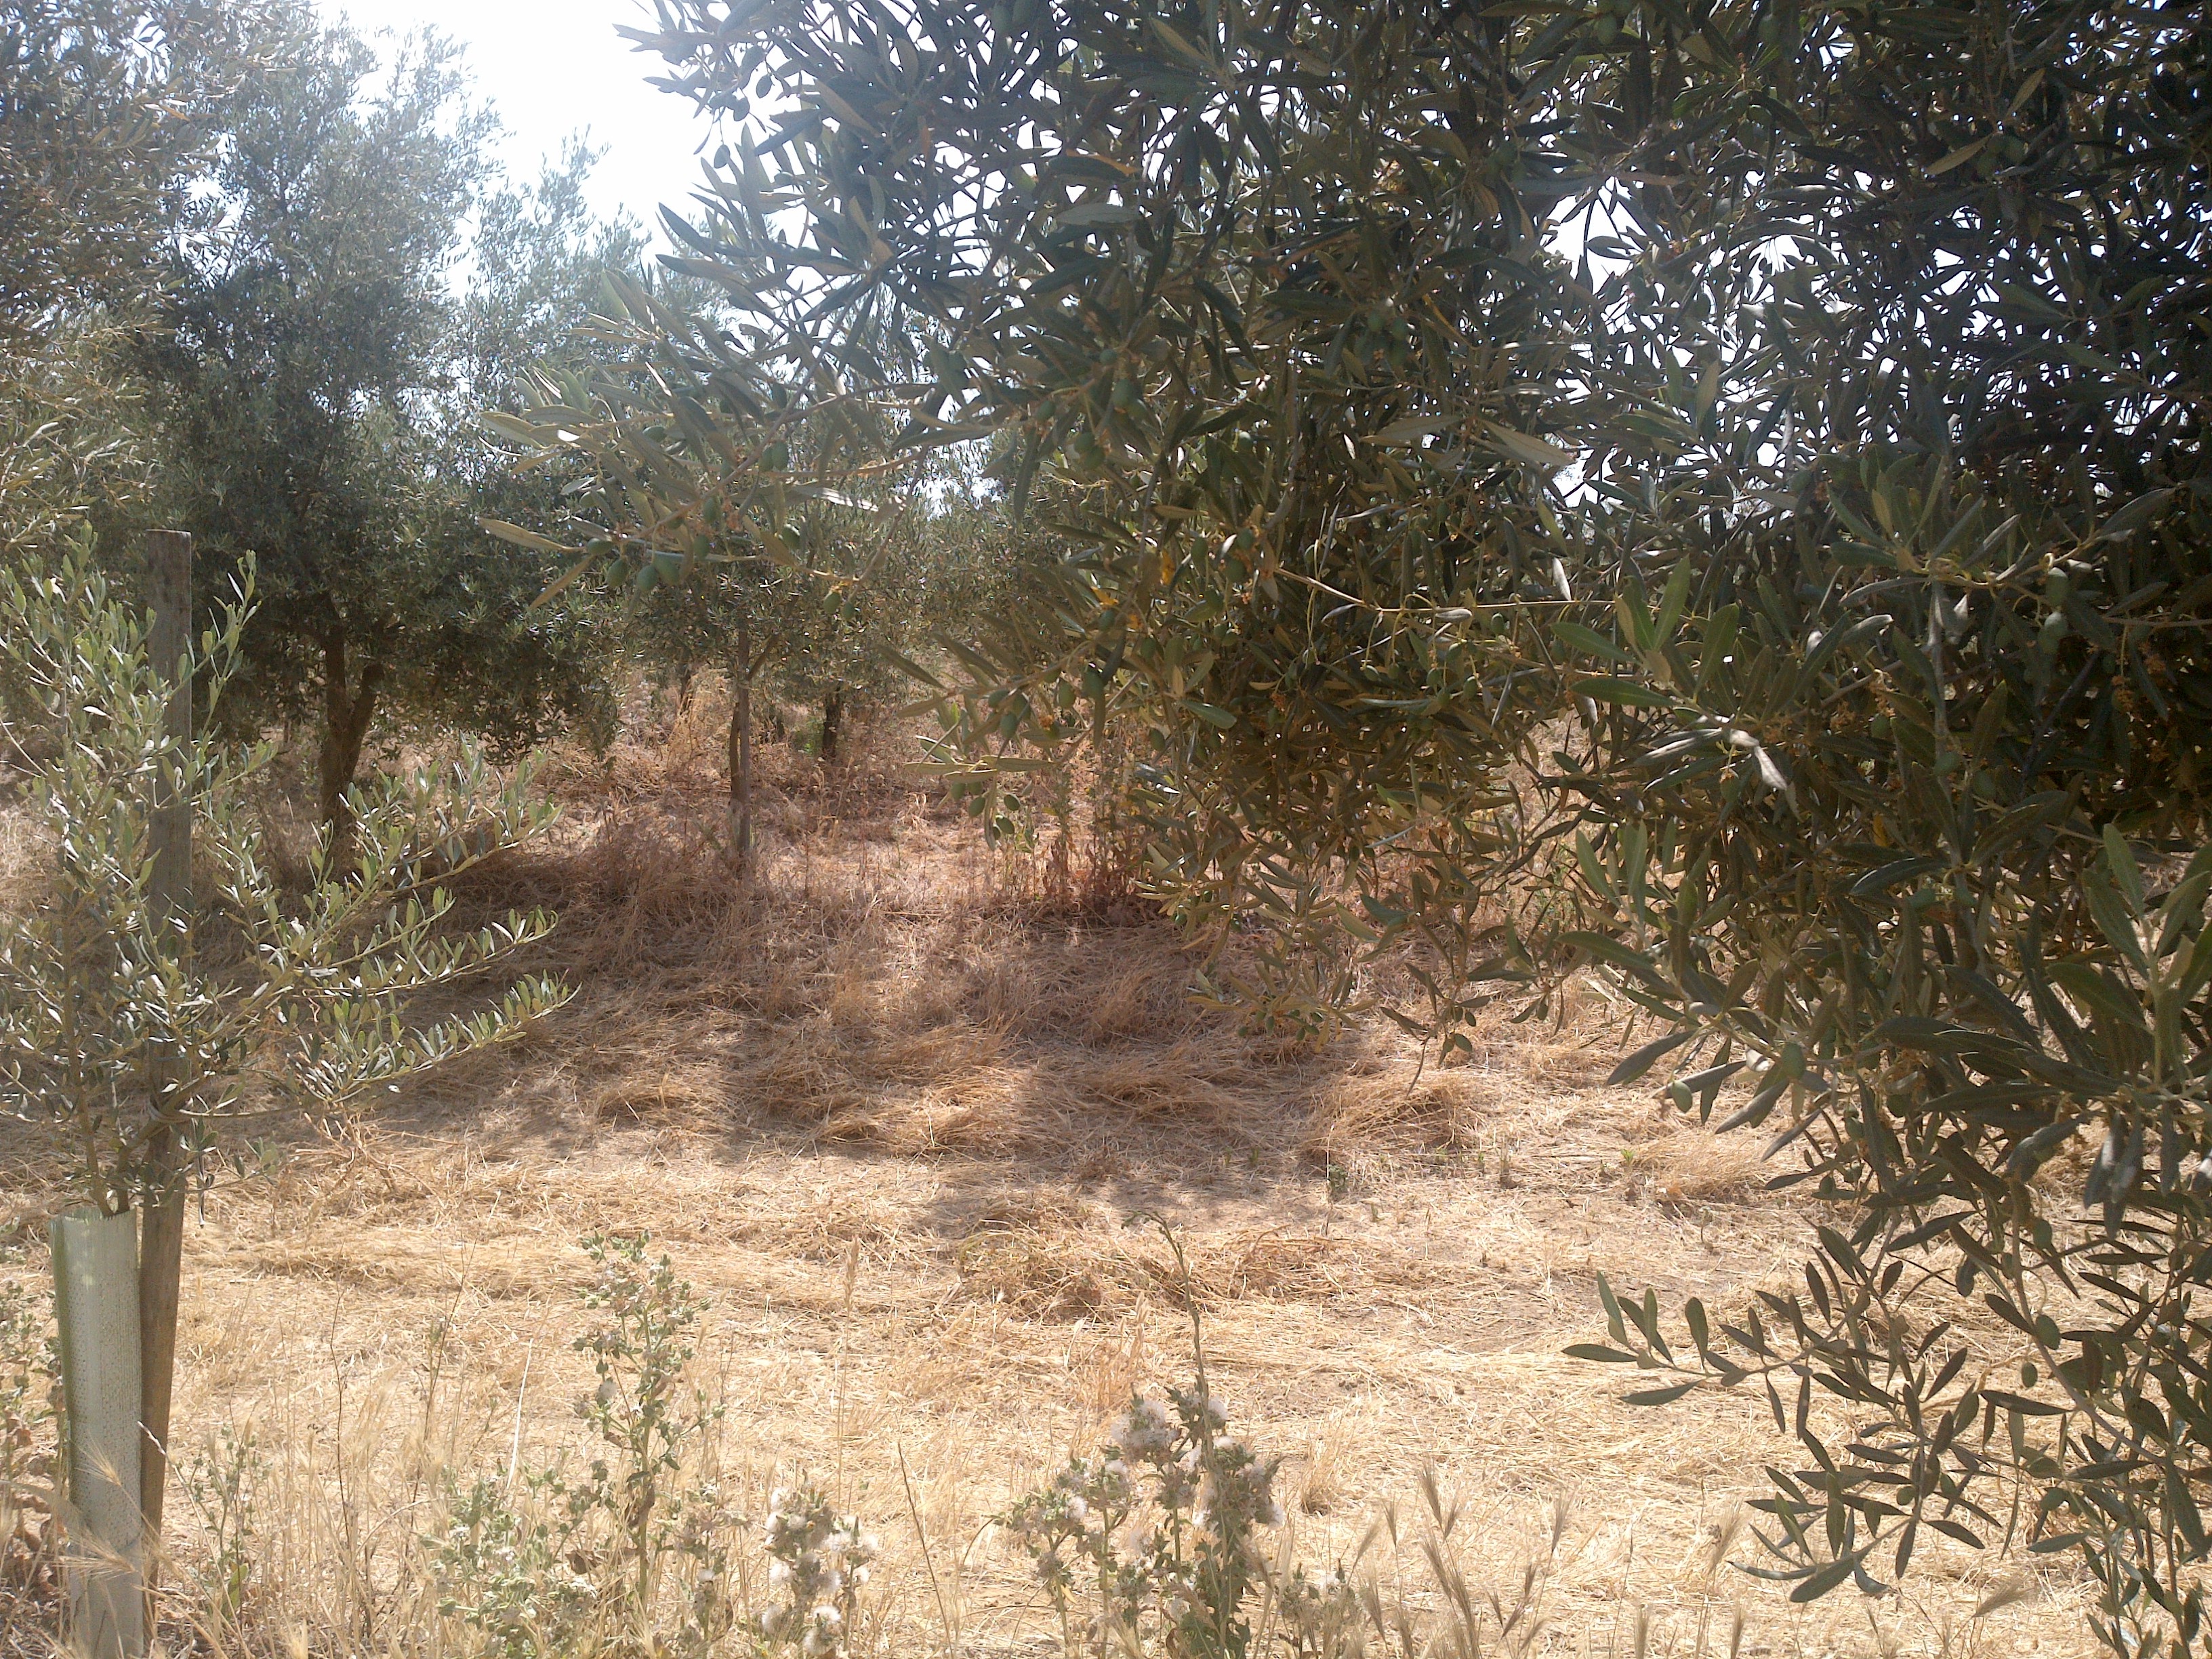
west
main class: Cropland
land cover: Olive groves
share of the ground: 25 - 50 %
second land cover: Spontaneously vegetated surfaces
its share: > 75 %
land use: Agriculture (excluding fallow land and kitchen gardens)
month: June
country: ES
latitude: 37.7845
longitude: -4.9926
